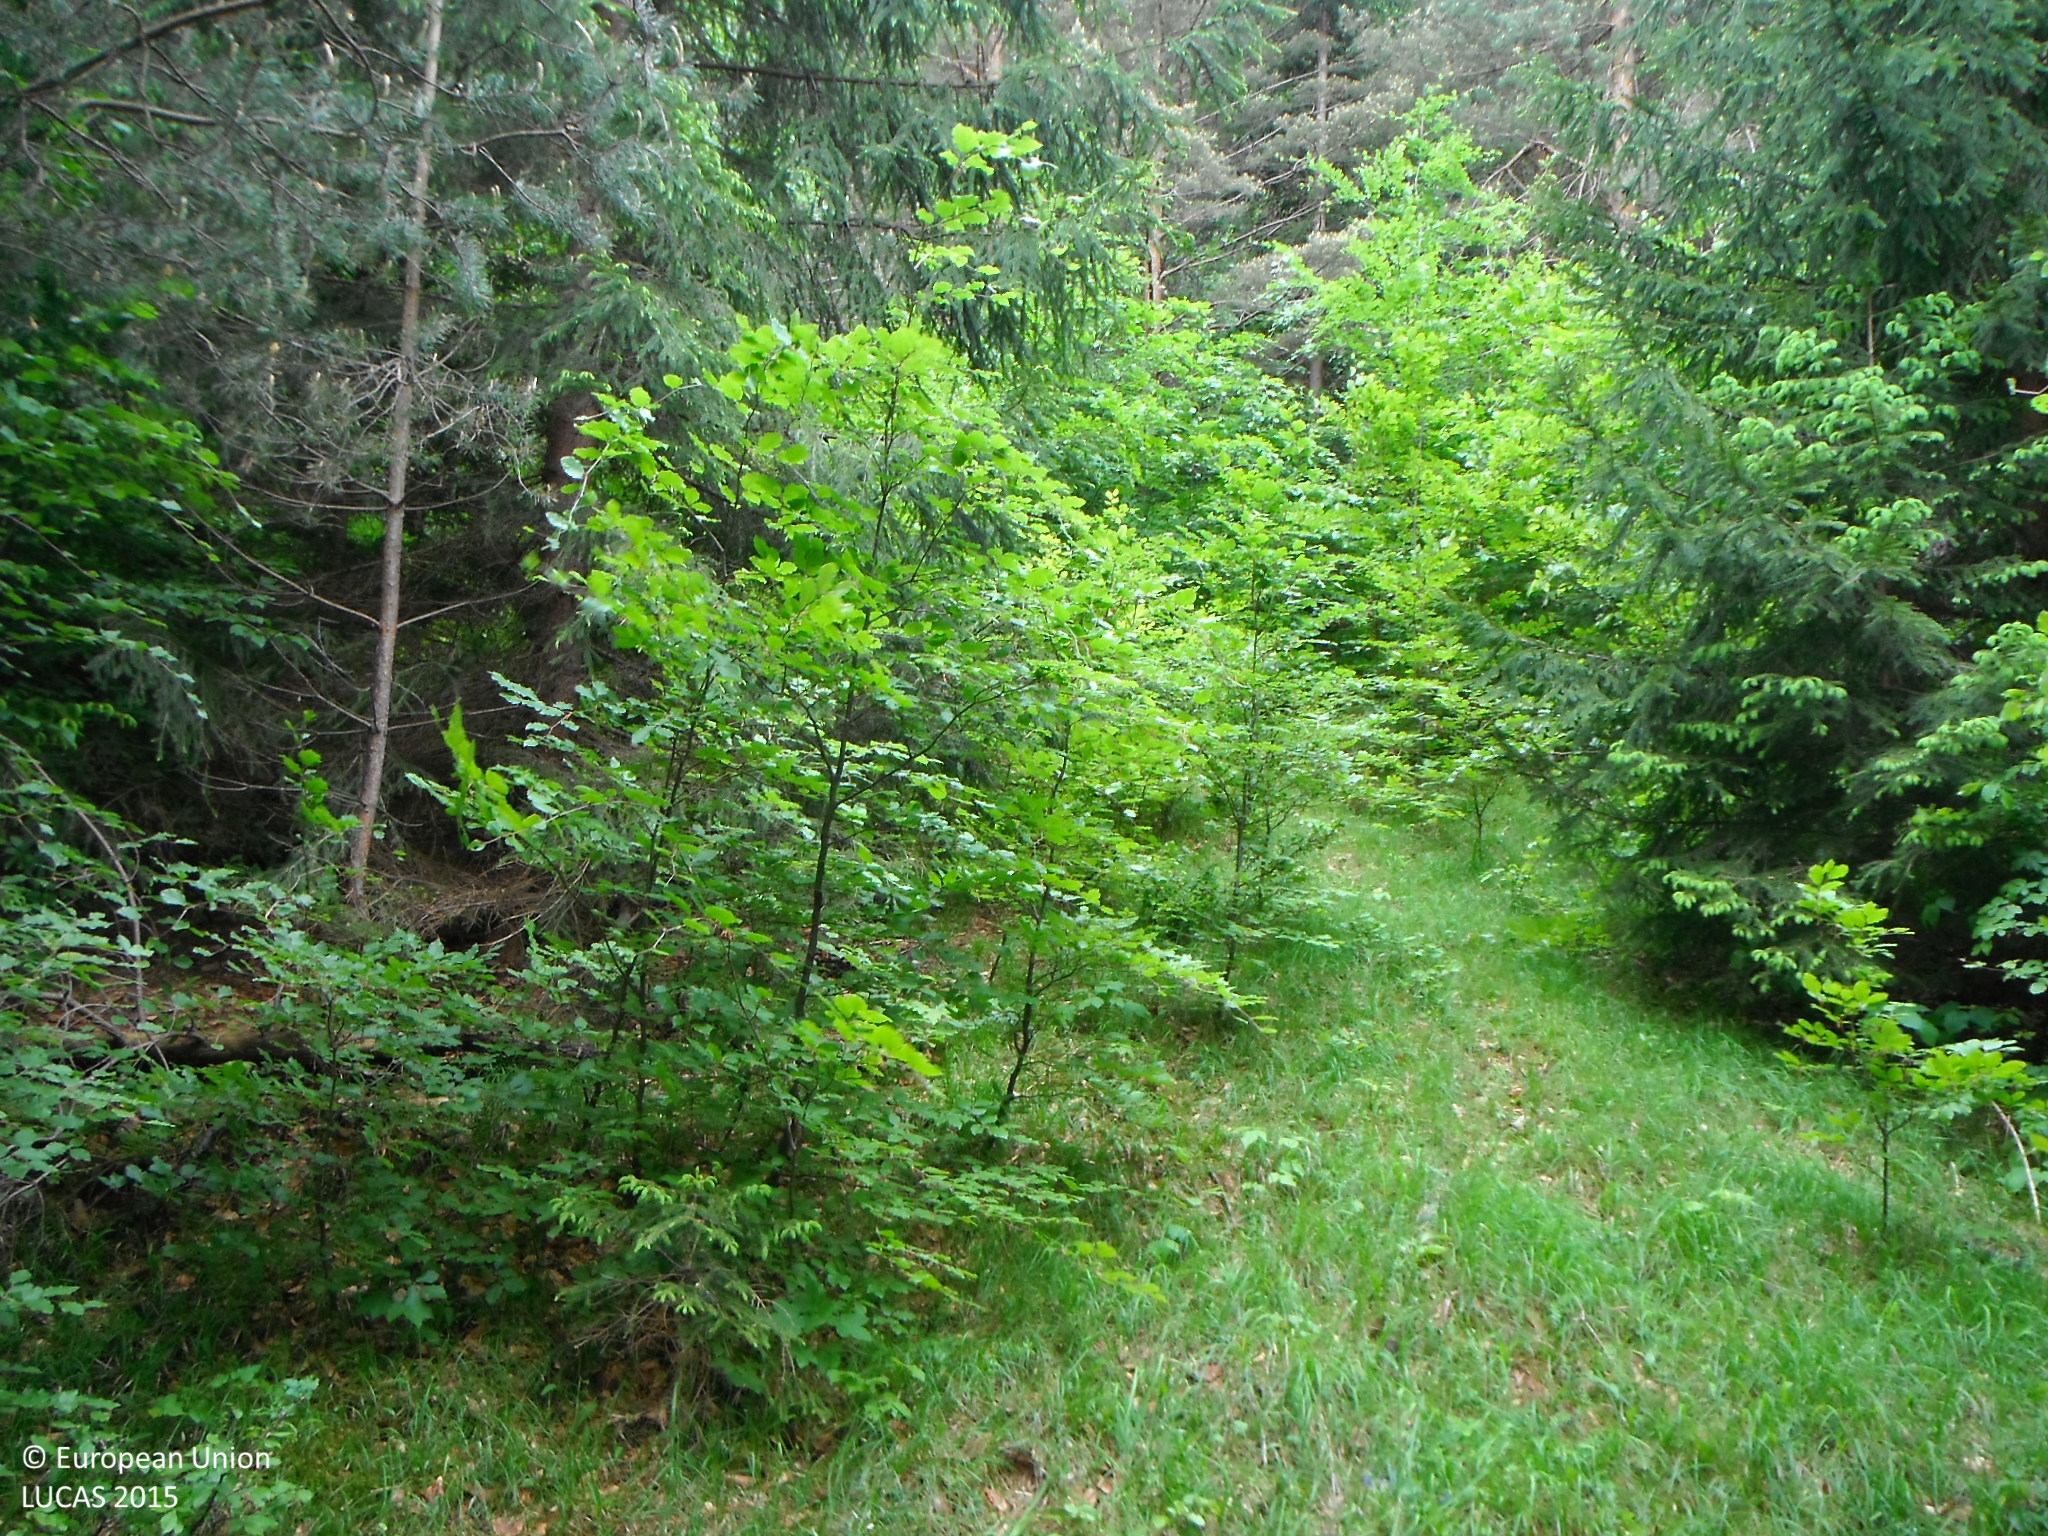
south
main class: Woodland
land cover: Pine dominated mixed woodland
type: hemiboreal forest and nemoral coniferous forest and mixed broadleaved-coniferous forest
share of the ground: > 75 %
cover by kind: broadleaved forest trees 55 %, coniferous forest trees 40 %, herbaceous plants 5 %
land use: Forestry
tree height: > 5 m
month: May
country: SK
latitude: 48.7545
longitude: 19.0670
